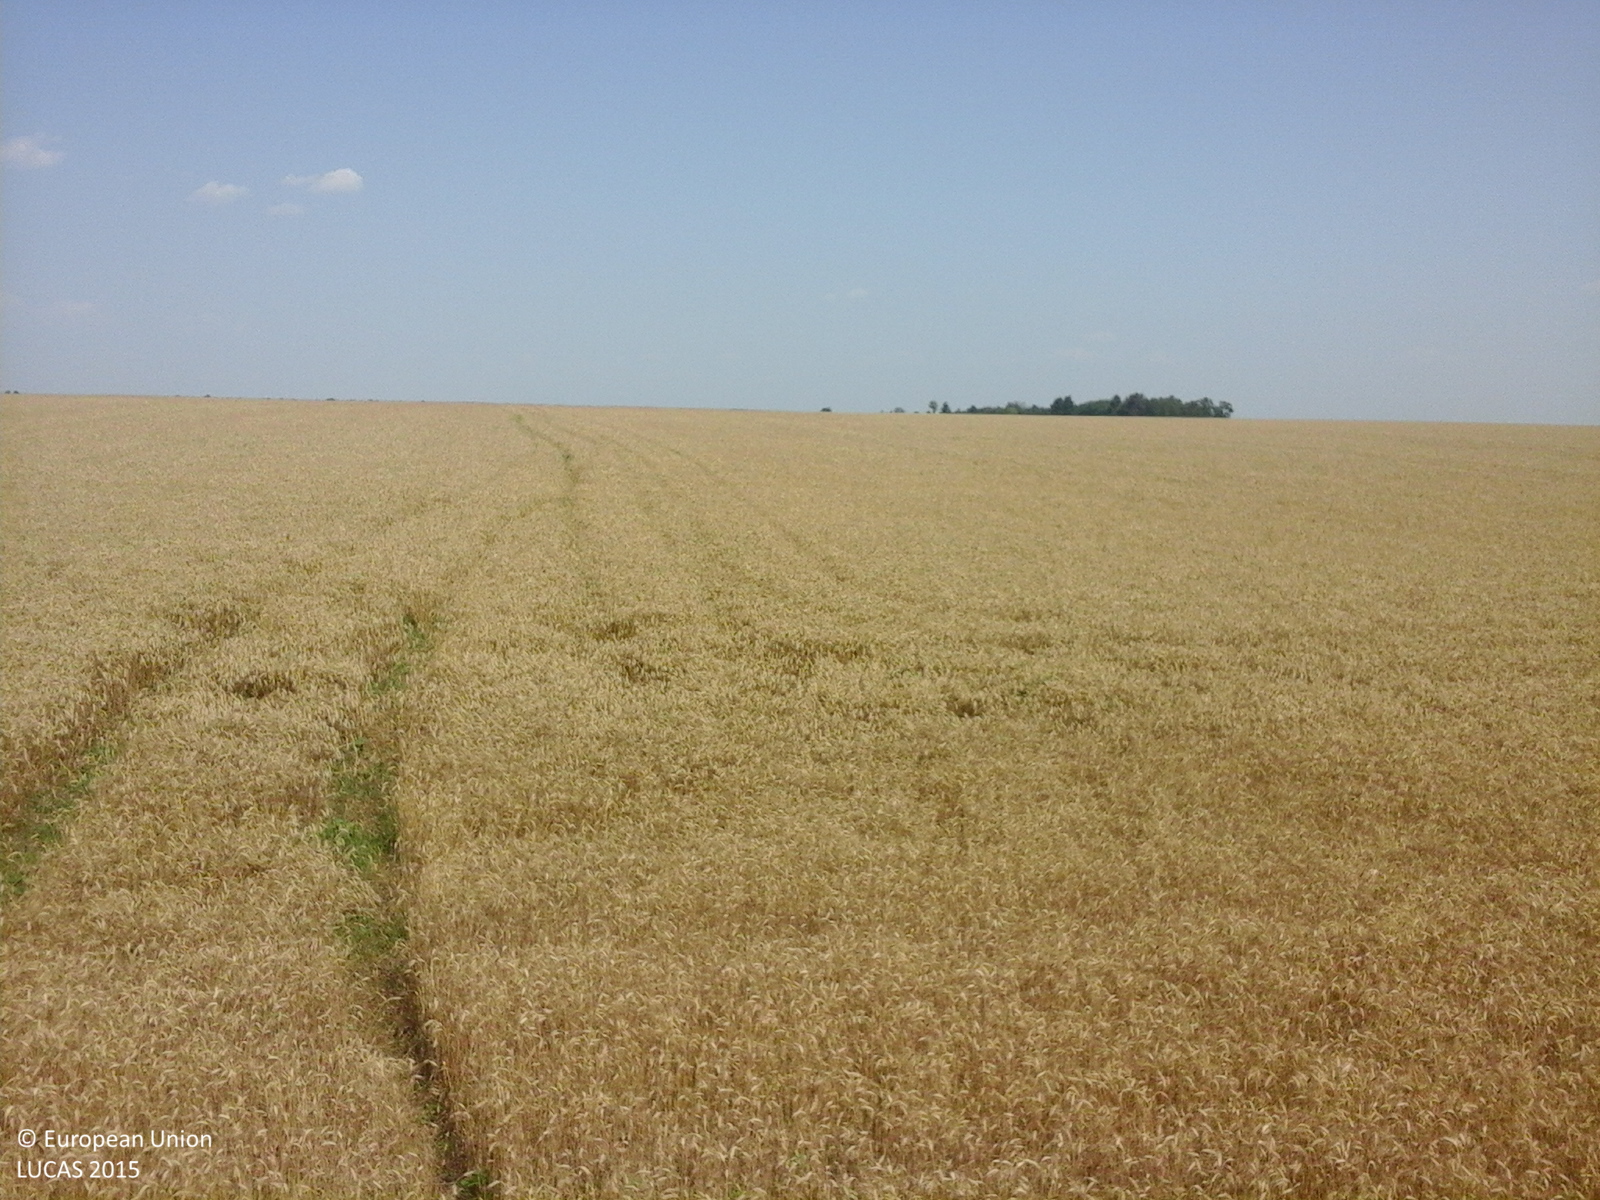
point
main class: Cropland
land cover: Common wheat
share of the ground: > 75 %
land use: Agriculture (excluding fallow land and kitchen gardens)
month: July
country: RO
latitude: 44.6809
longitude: 24.4927
